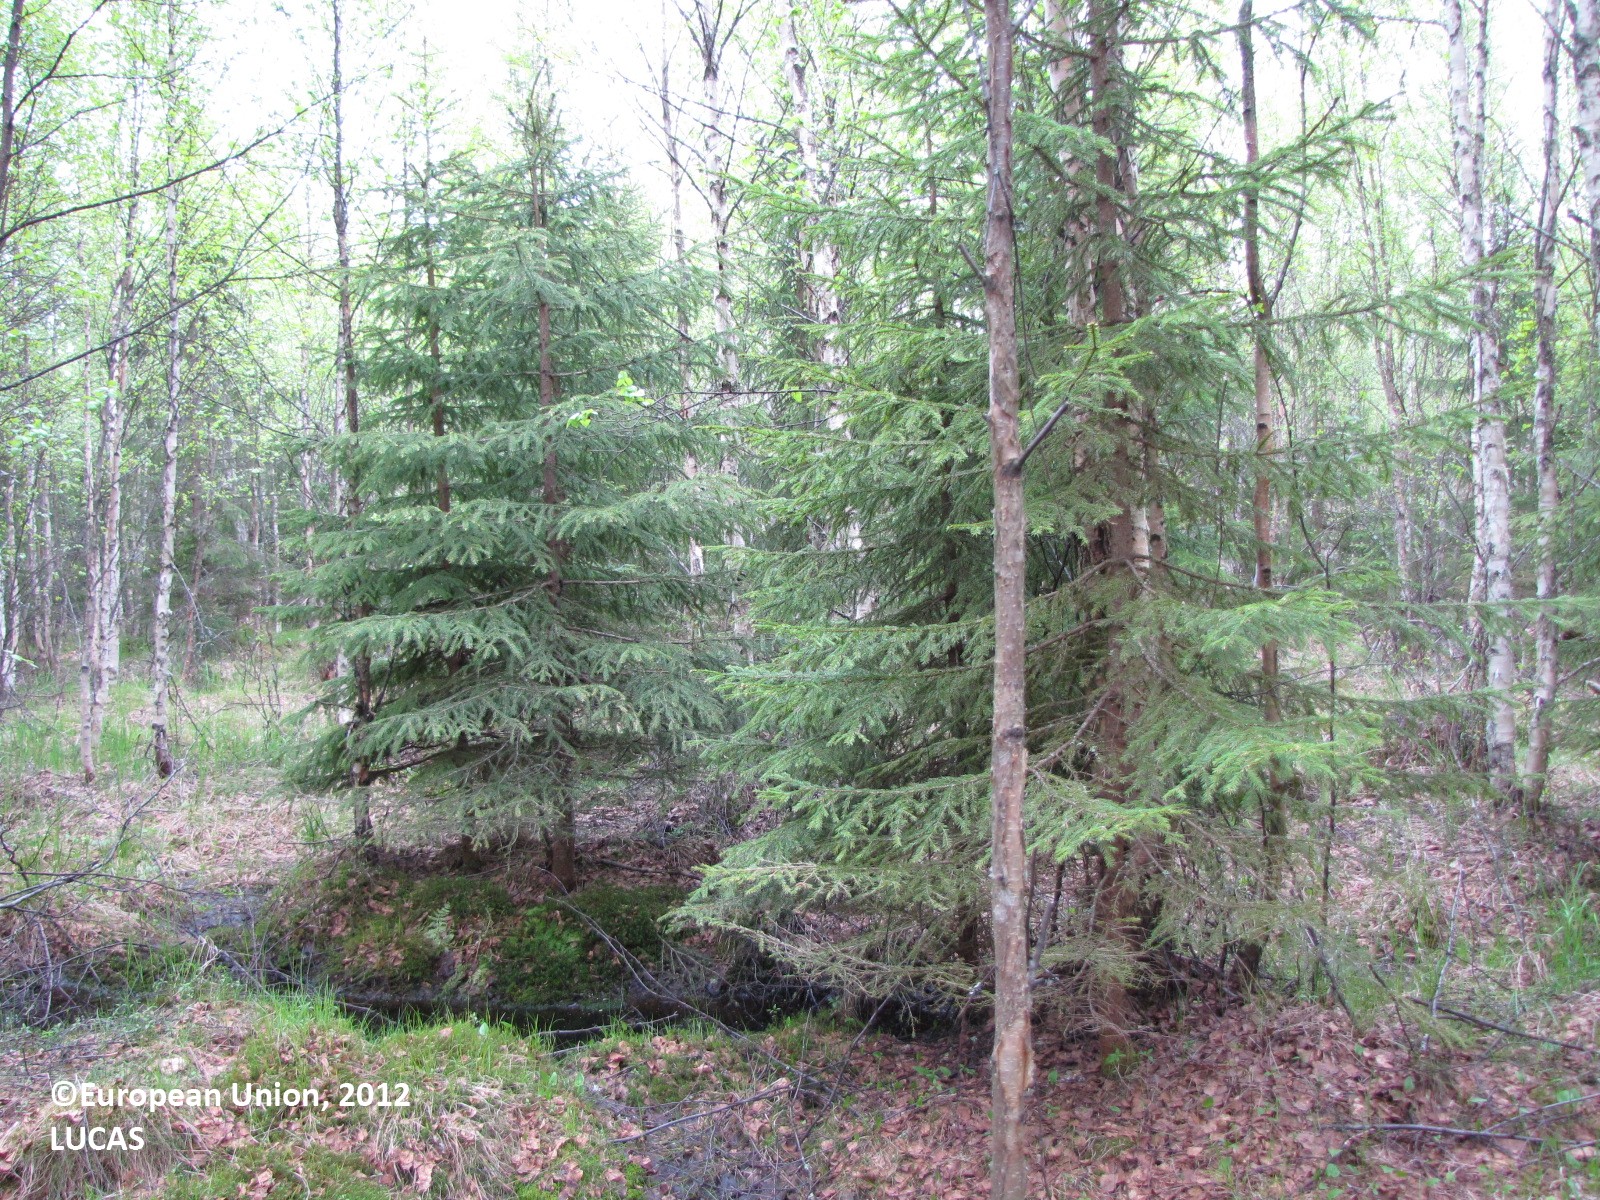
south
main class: Woodland
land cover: Spruce dominated mixed woodland
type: boreal forest
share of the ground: 50 - 75 %
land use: Forestry
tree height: > 5 m
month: June
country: FI
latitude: 65.8462
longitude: 24.5305
